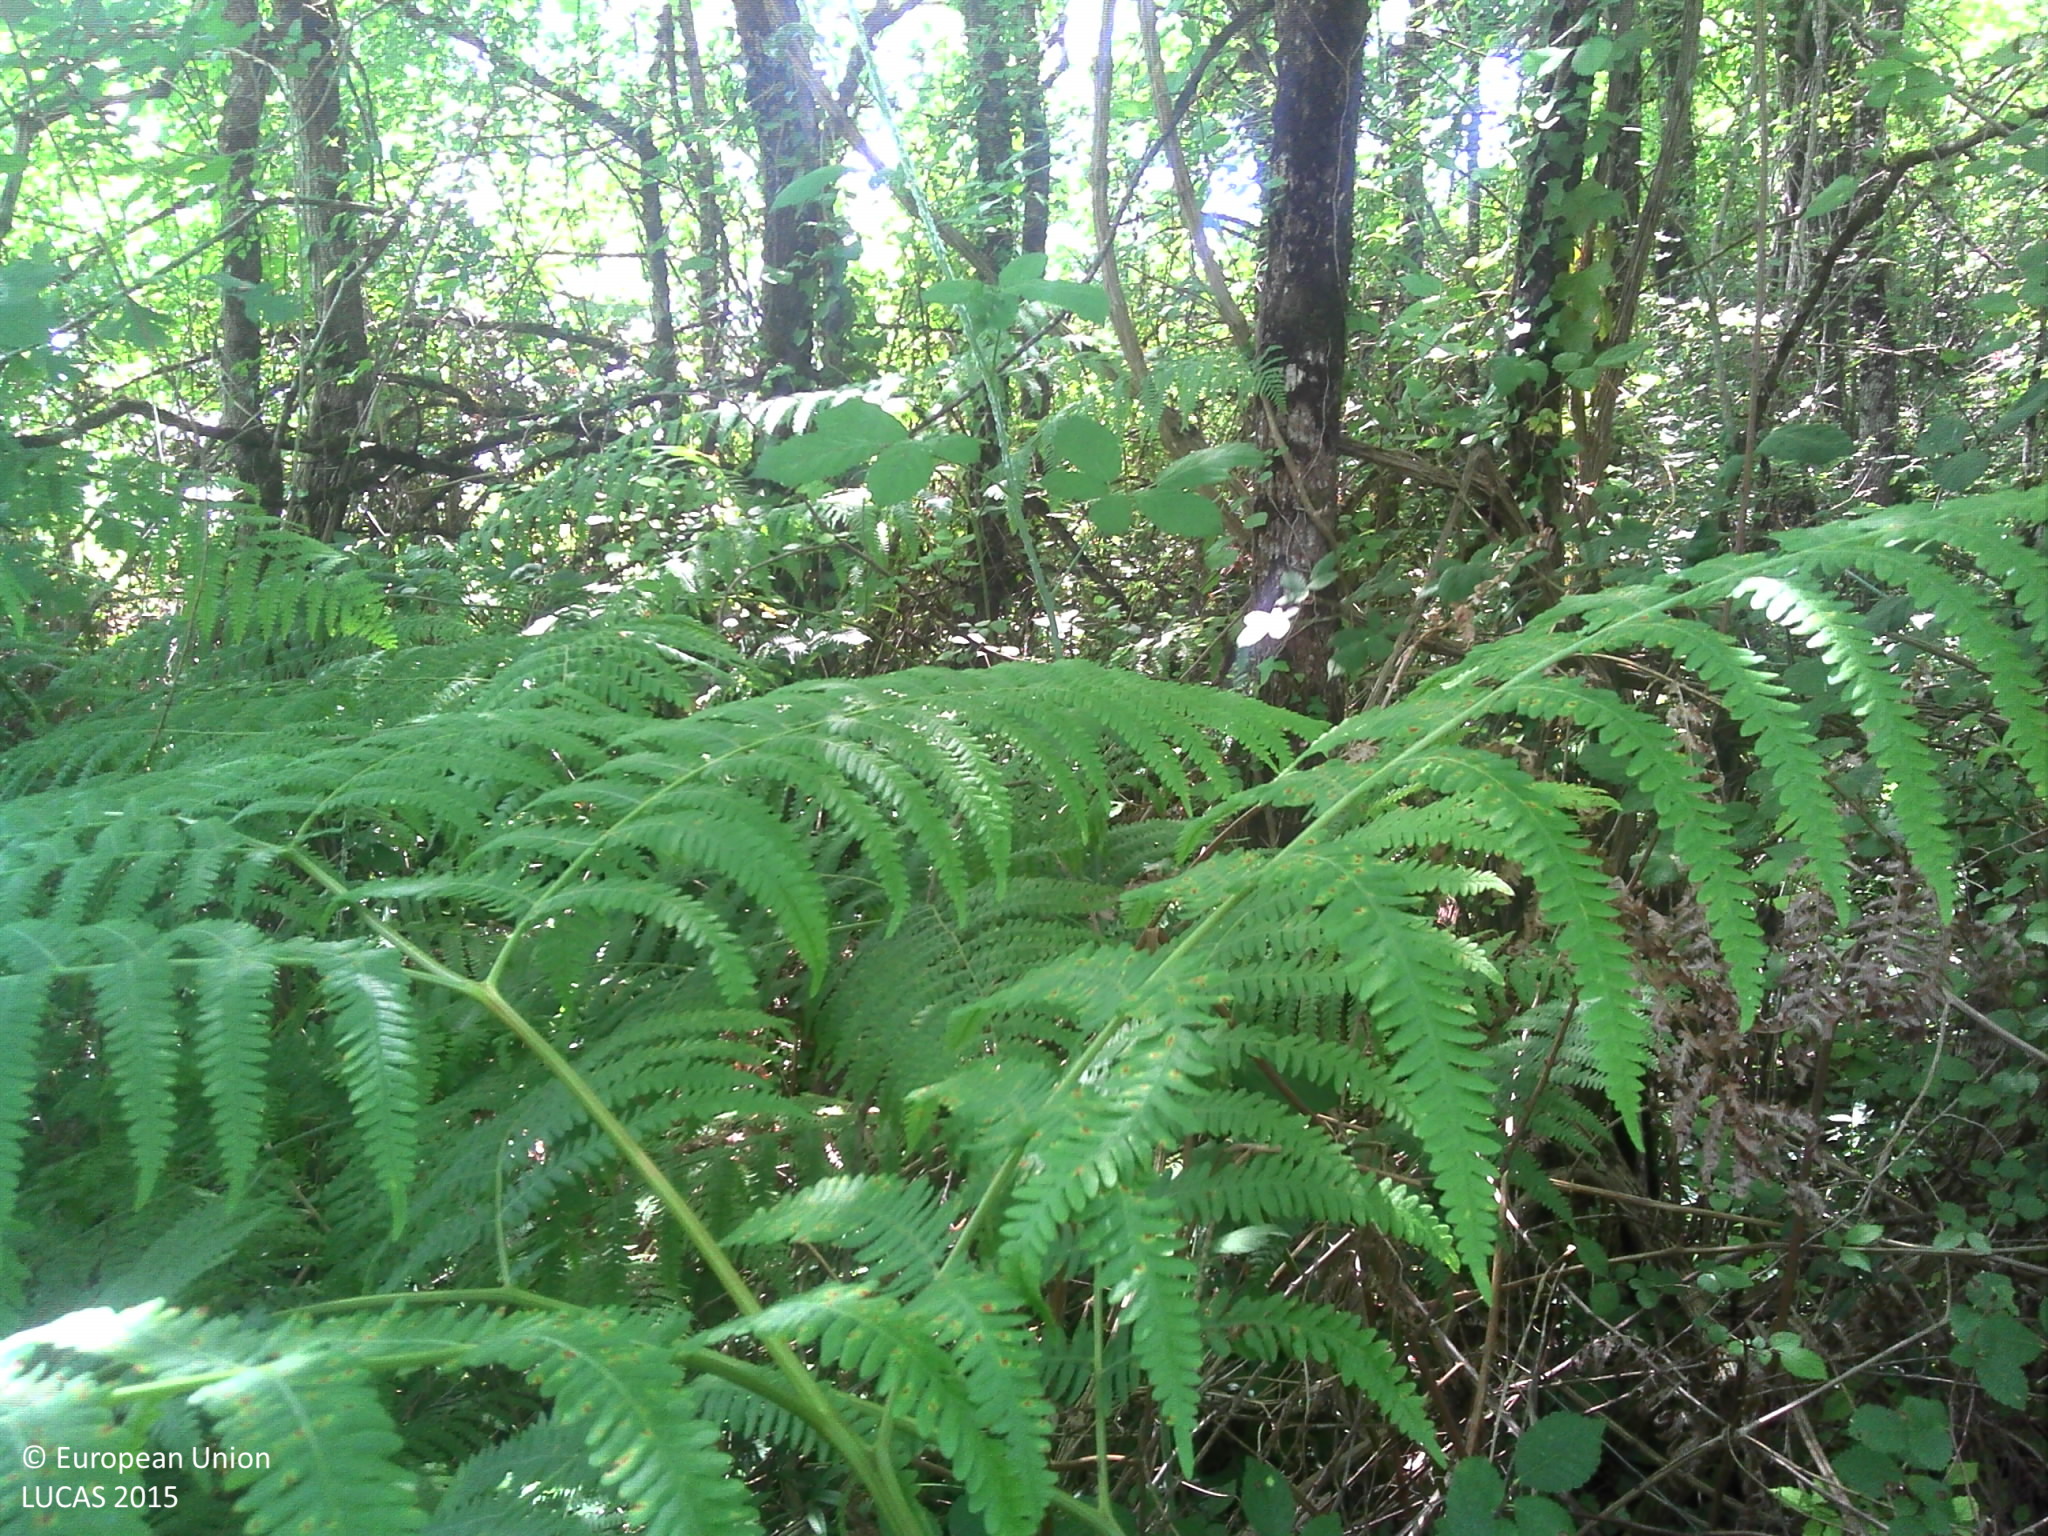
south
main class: Woodland
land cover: Broadleaved woodland
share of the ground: > 75 %
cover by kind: broadleaved forest trees 95 %, coniferous forest trees 5 %
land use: Semi-natural and natural areas not in use
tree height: < 5 m
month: June
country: FR
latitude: 44.1860
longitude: 0.9017
